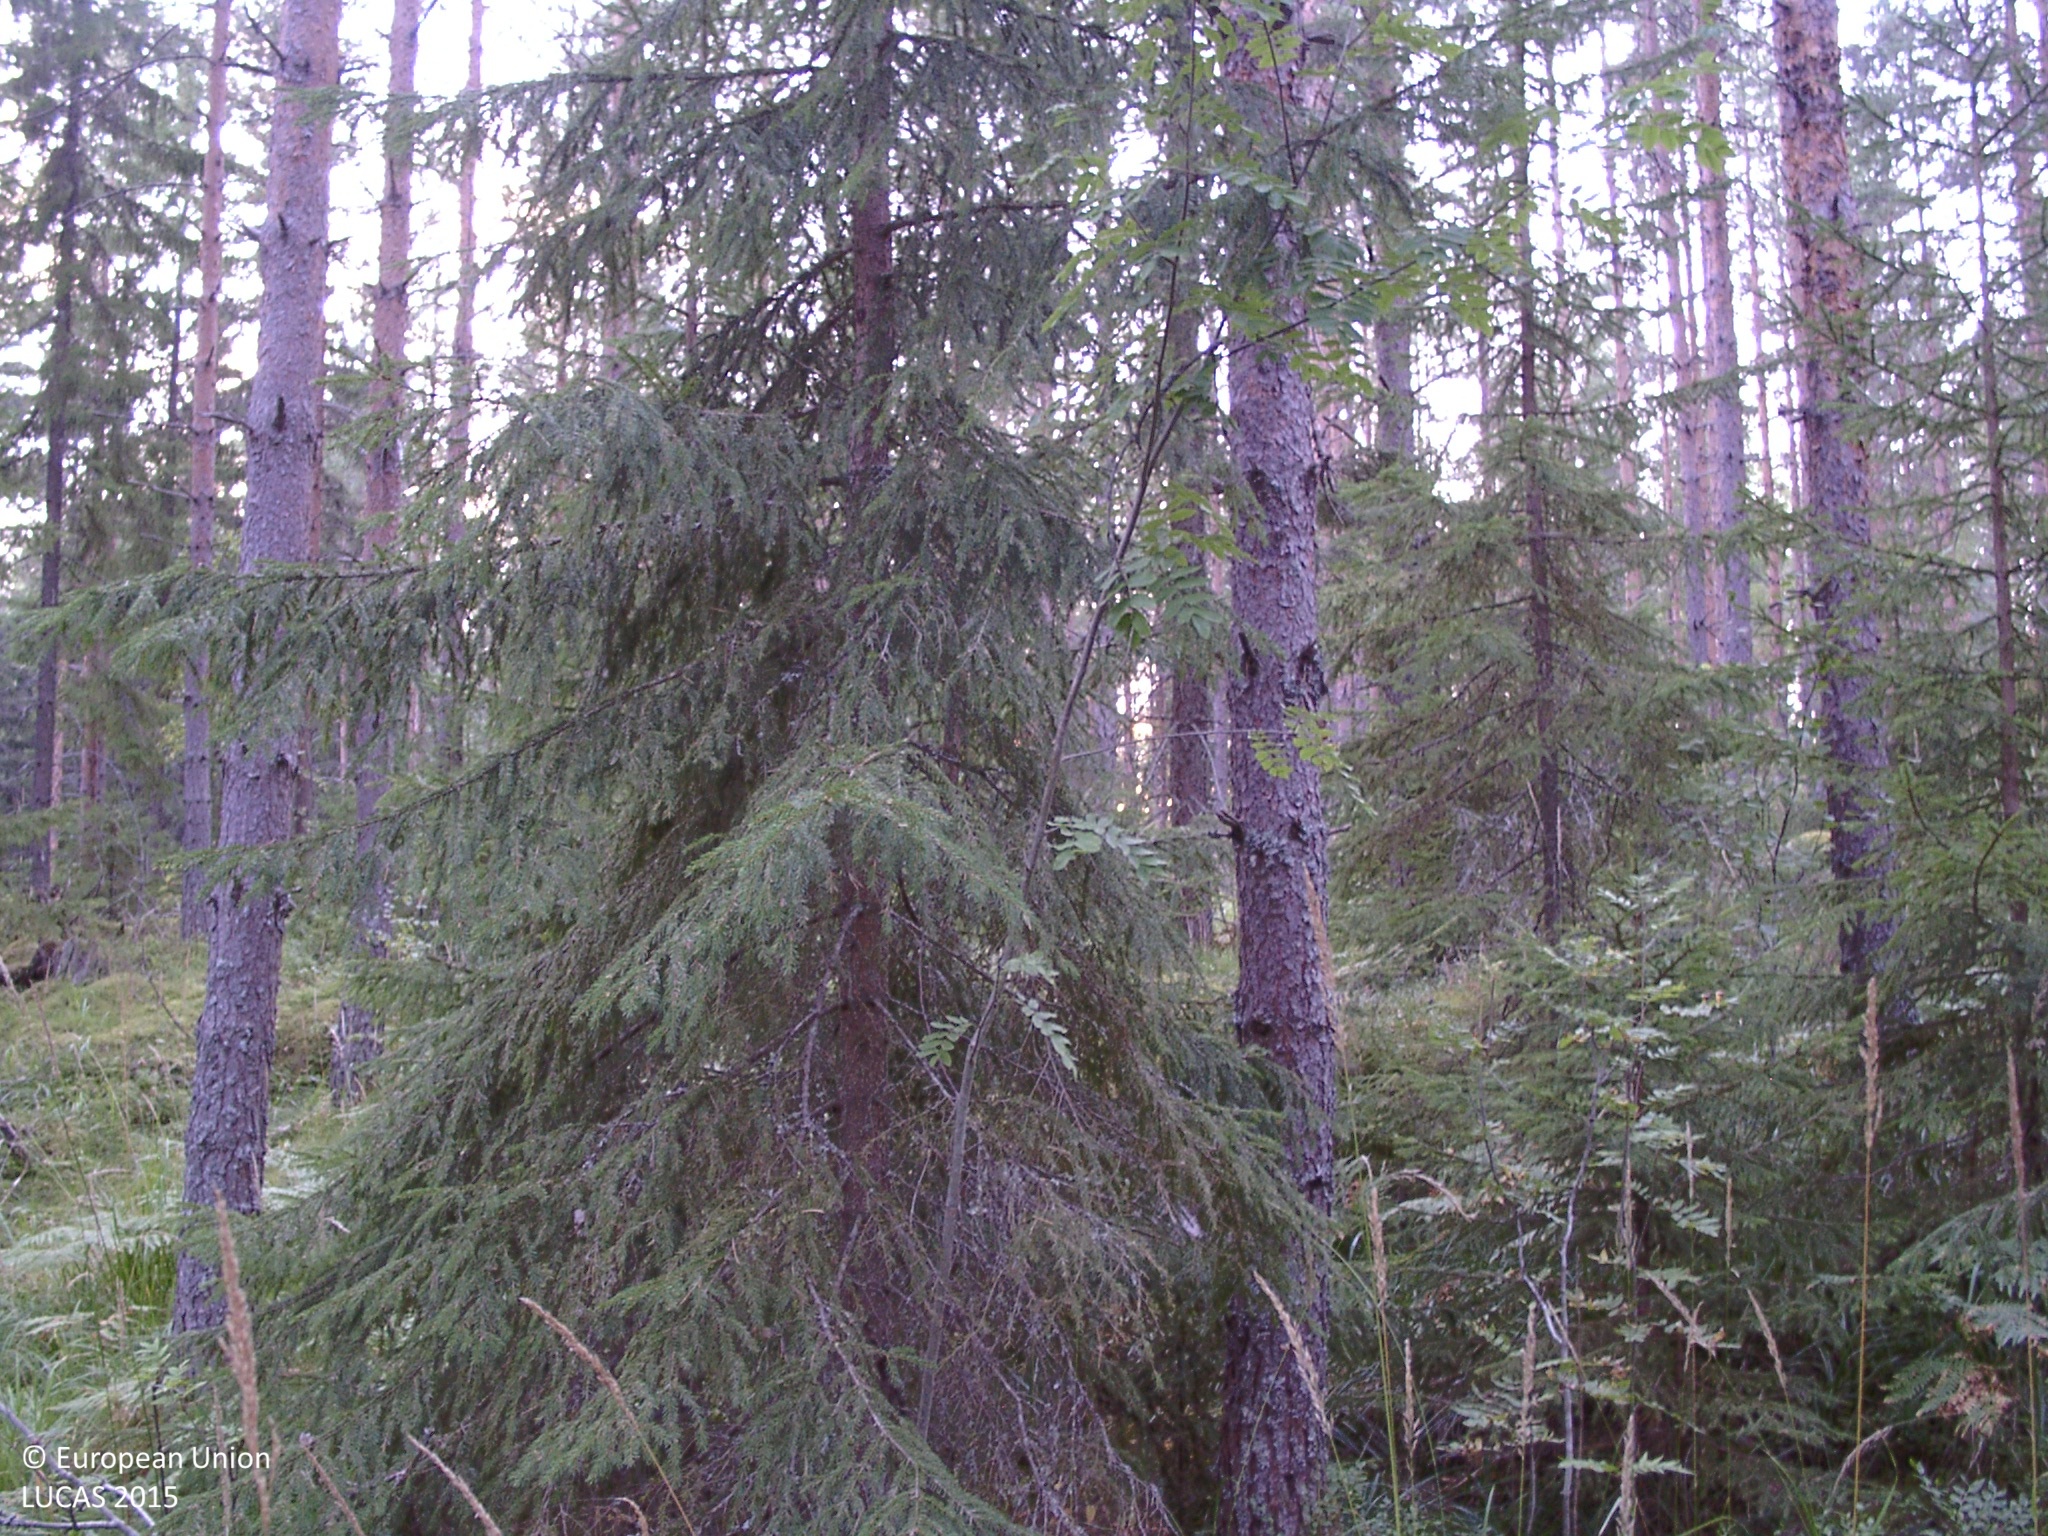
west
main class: Woodland
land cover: Other coniferous woodland
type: boreal forest
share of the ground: > 75 %
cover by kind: coniferous forest trees 75 %, herbaceous plants 15 %, shrubs 5 %, lichens and mosses 5 %
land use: Forestry
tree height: > 5 m
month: August
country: FI
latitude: 61.7394
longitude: 25.0460
